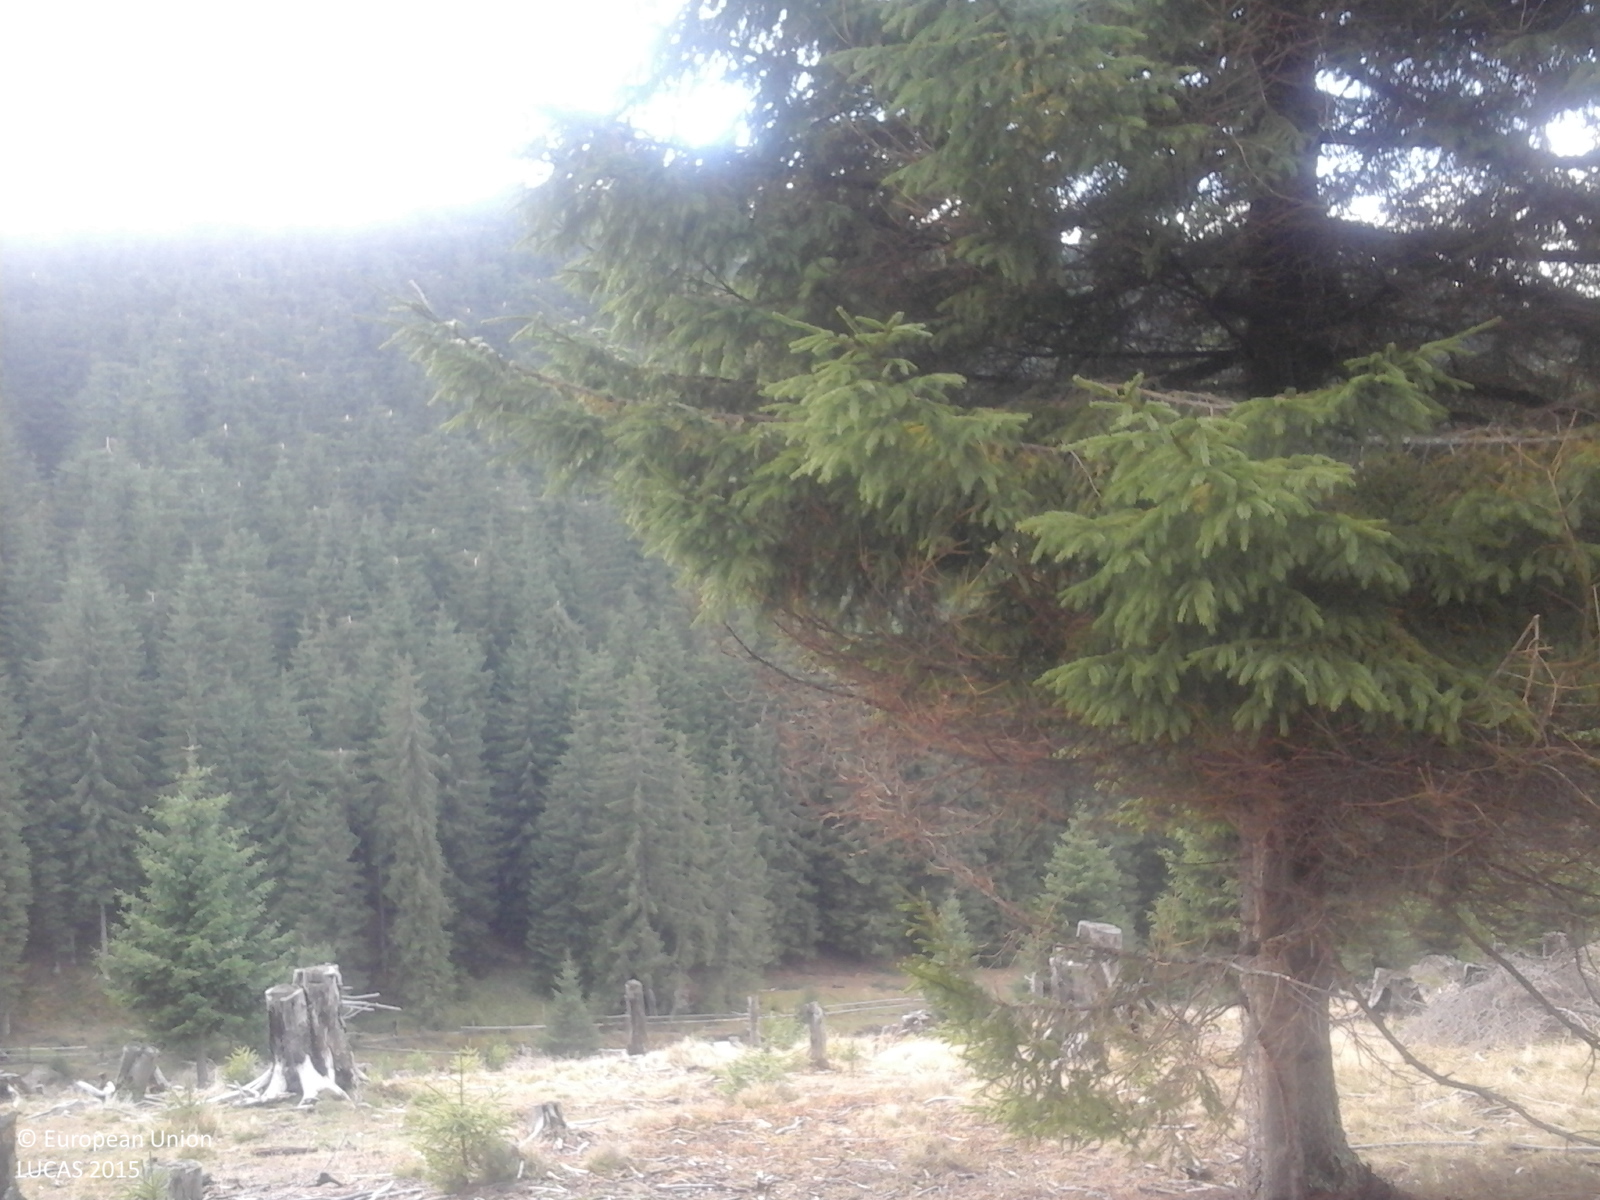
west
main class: Grassland
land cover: Grassland with sparse tree/shrub cover
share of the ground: > 75 %
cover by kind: herbaceous plants 85 %, shrubs 10 %, broadleaved forest trees 5 %
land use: Forestry
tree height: < 5 m
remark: Clear cut
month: October
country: RO
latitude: 46.5038
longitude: 26.0597
